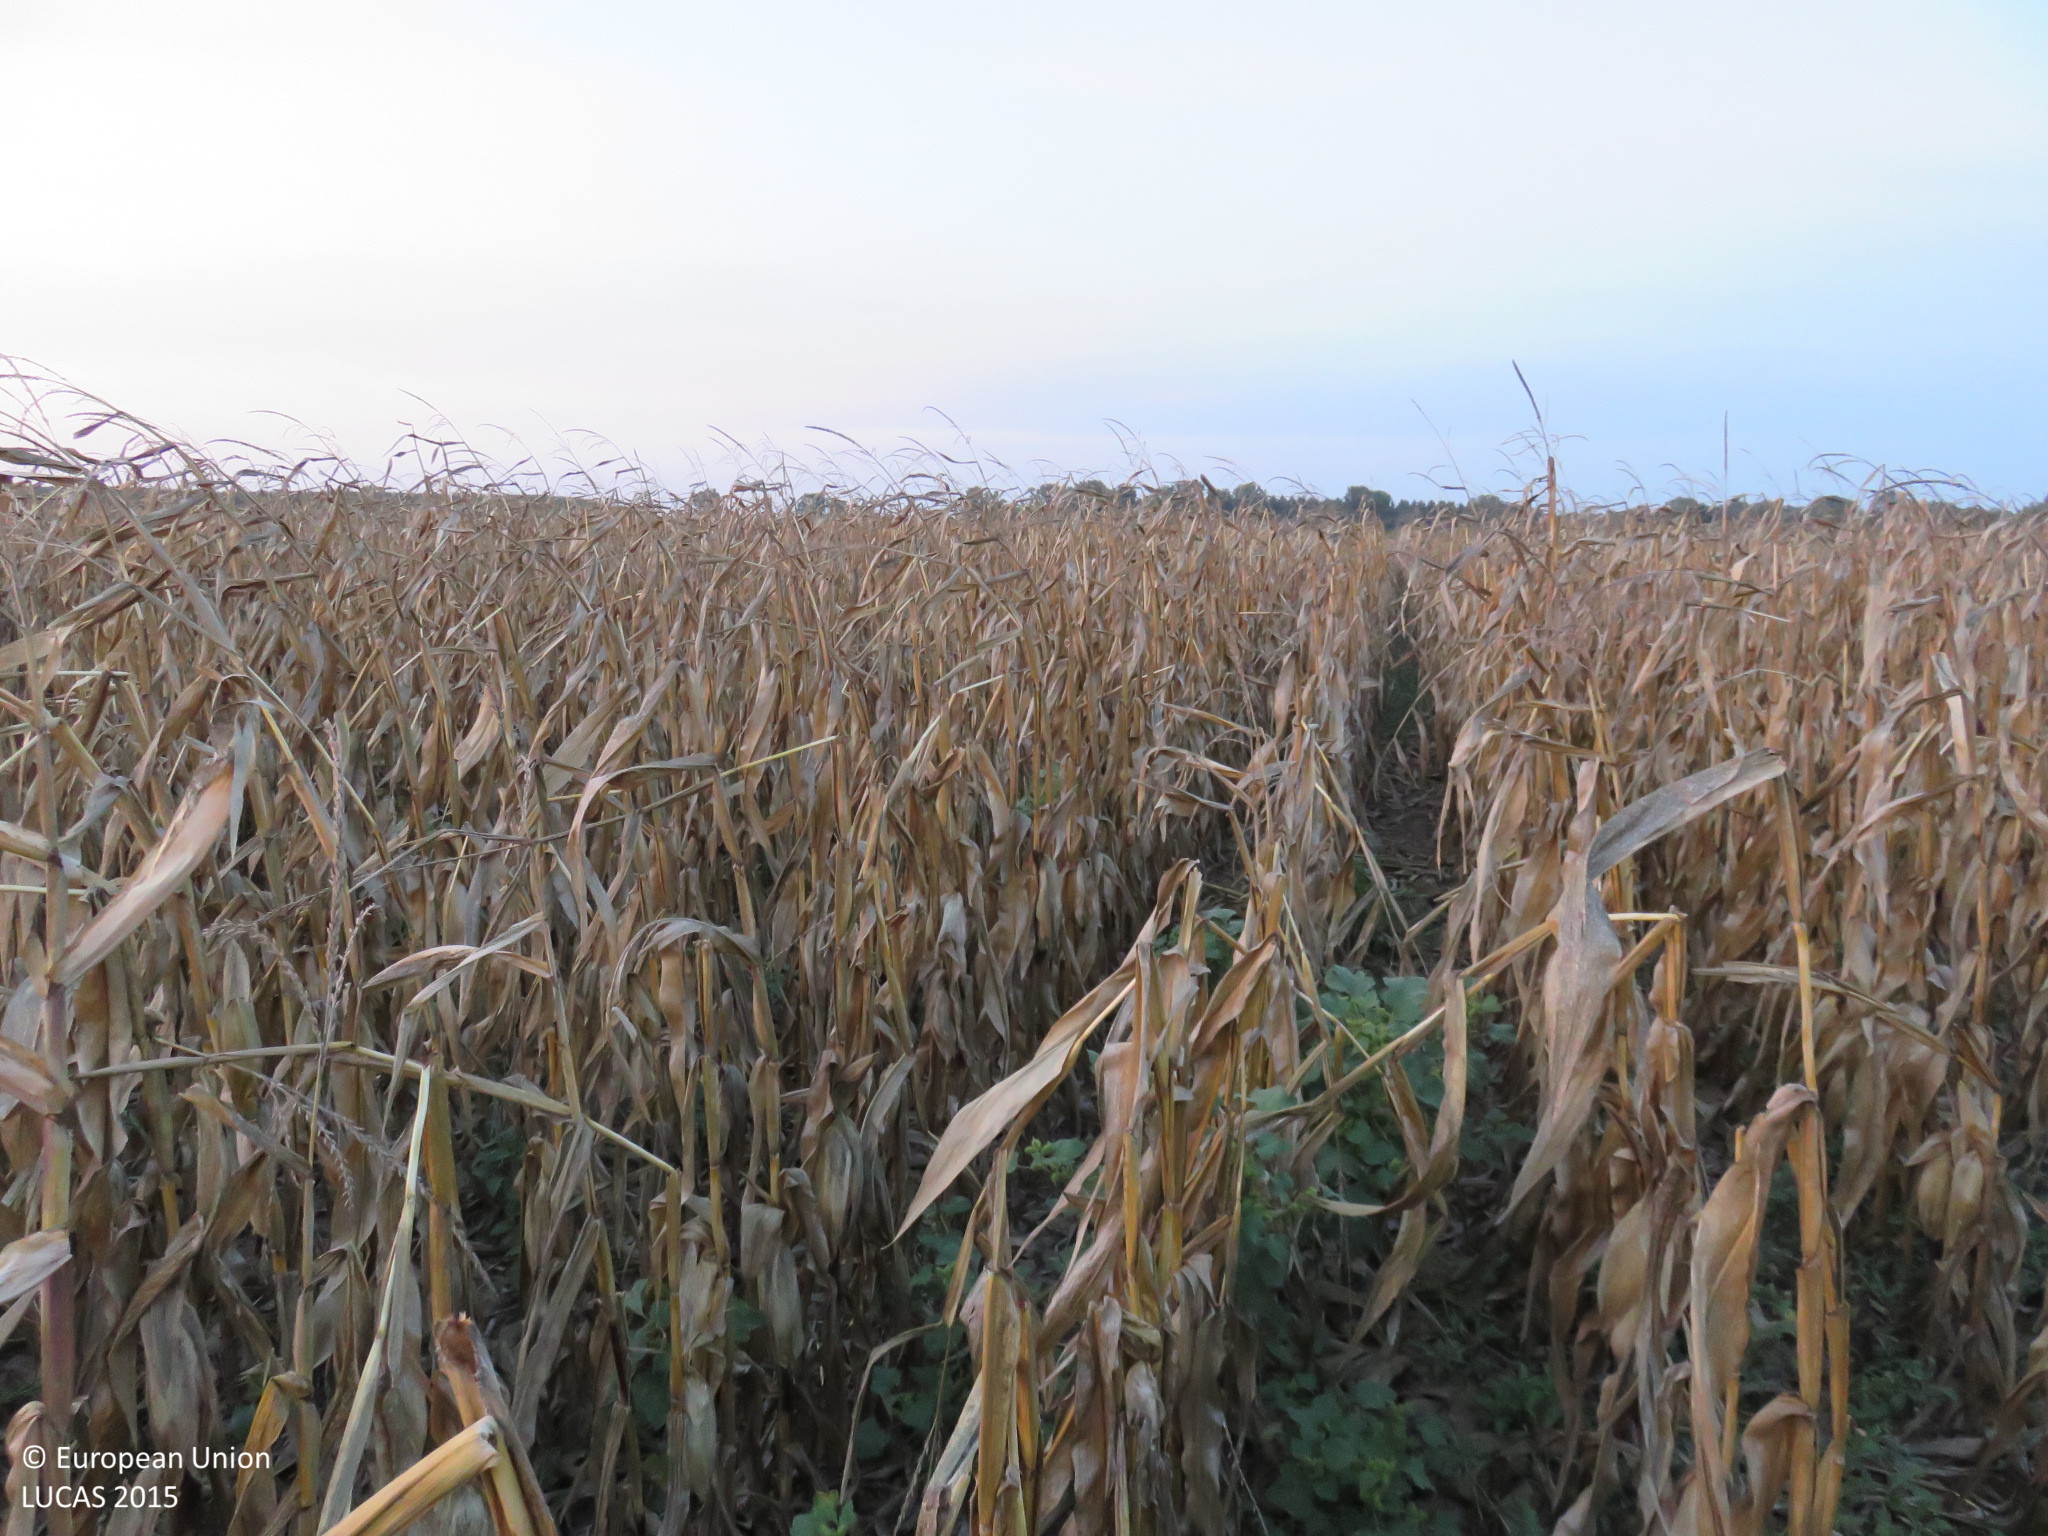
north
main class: Cropland
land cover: Maize
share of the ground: > 75 %
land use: Agriculture (excluding fallow land and kitchen gardens)
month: September
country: BG
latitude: 43.7319
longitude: 24.6039
